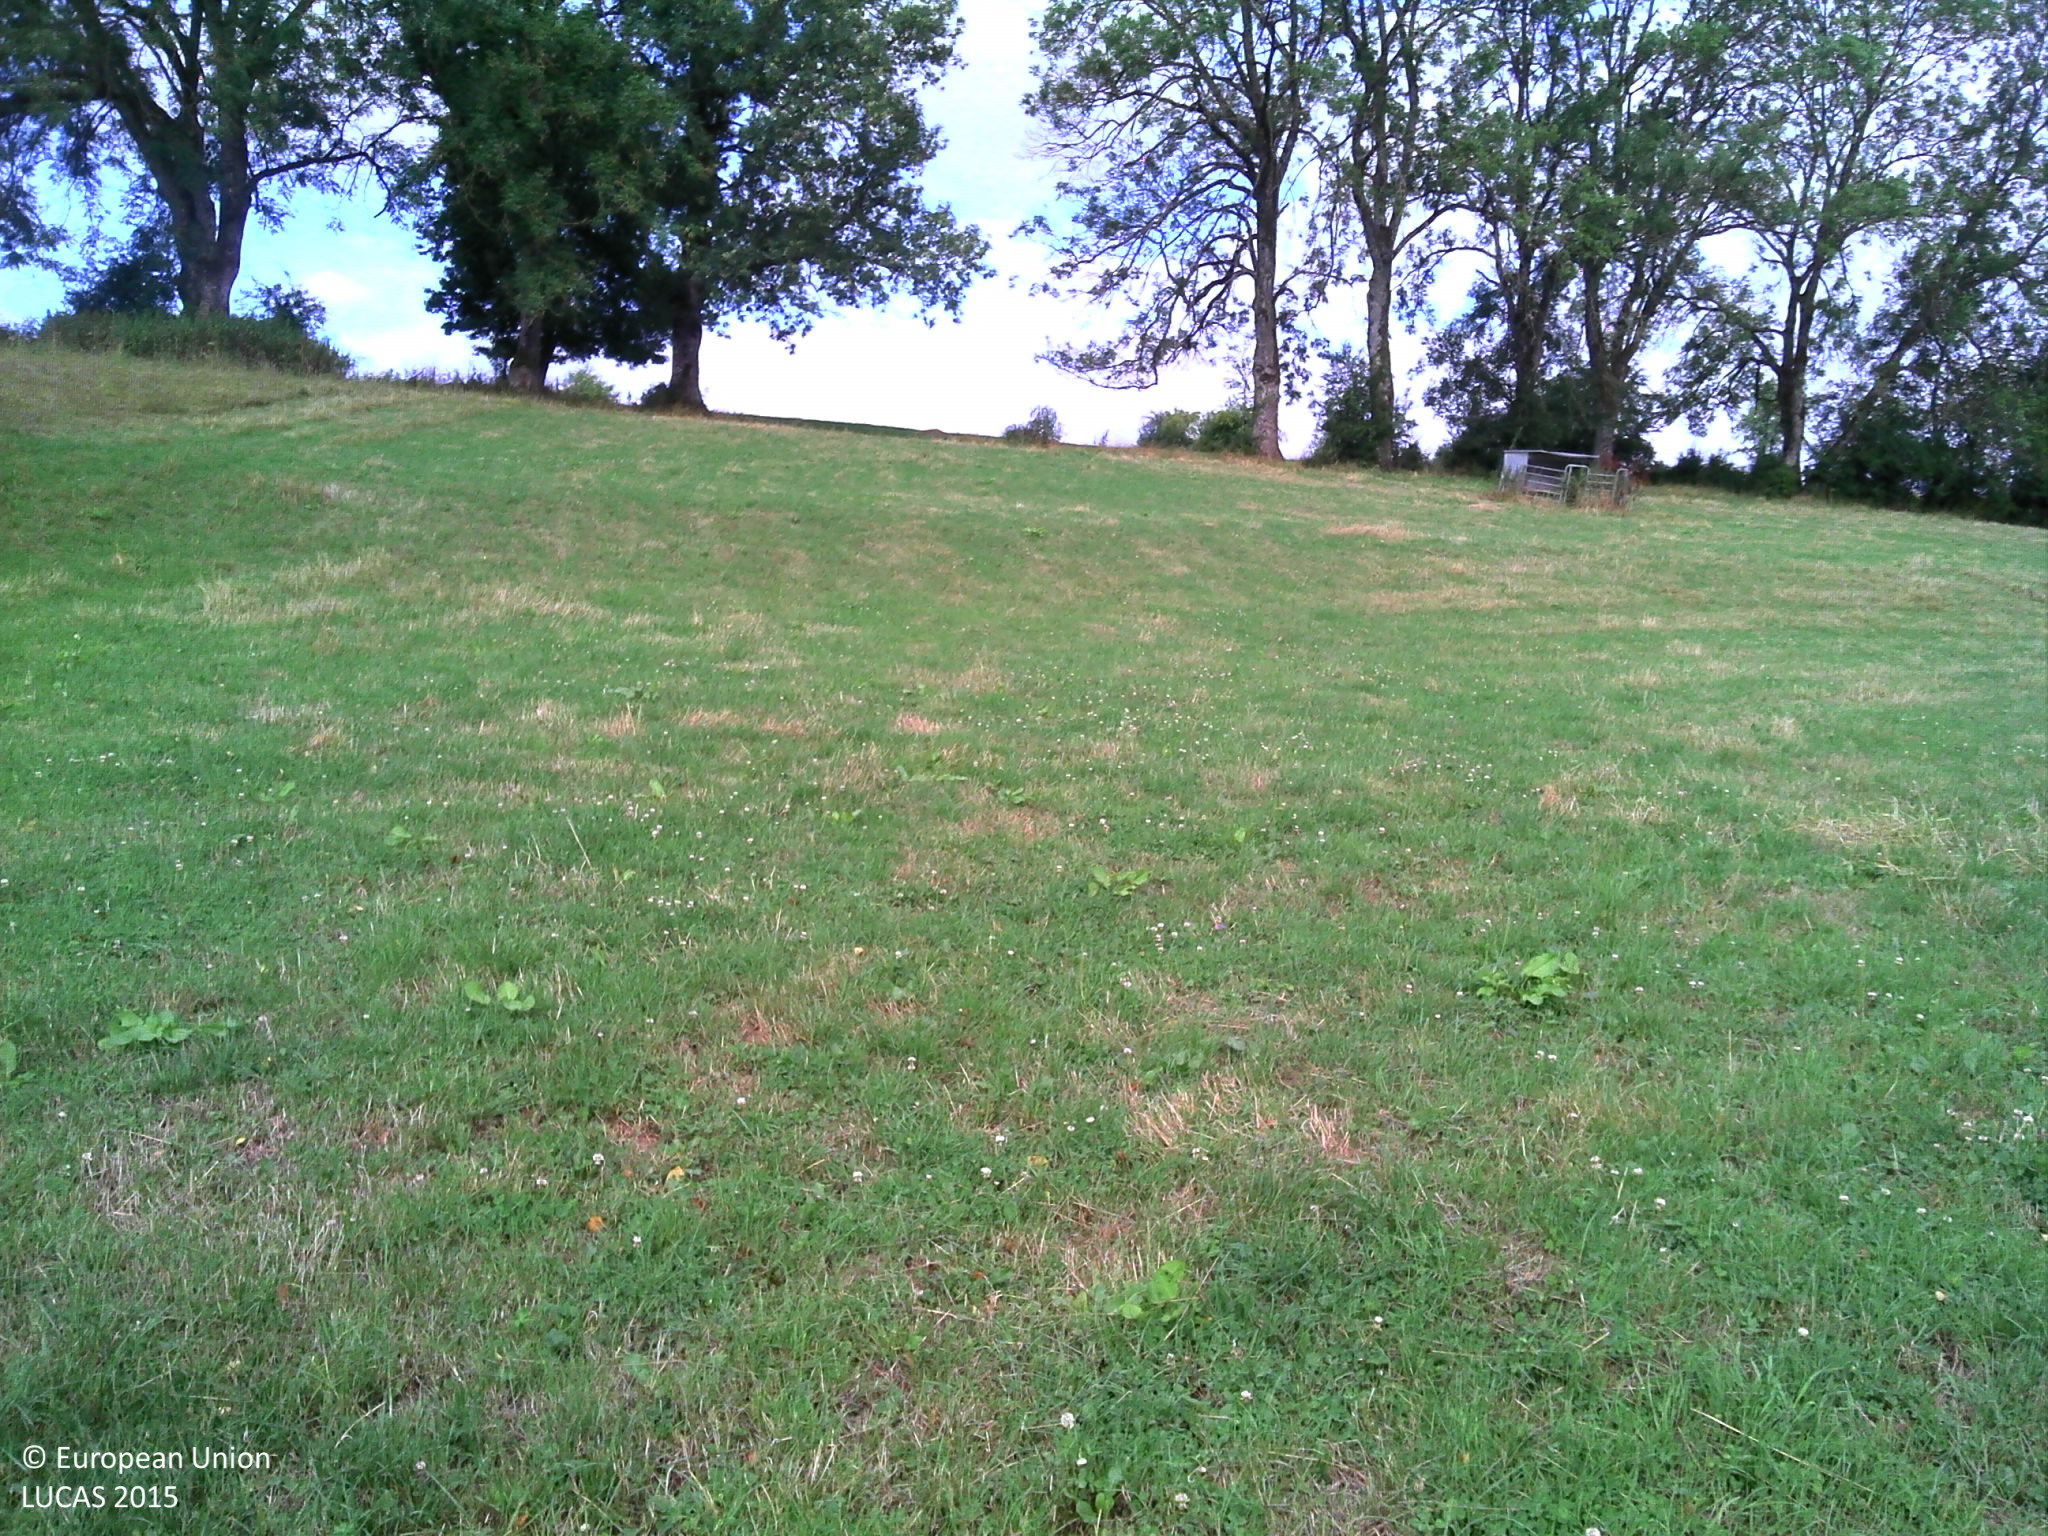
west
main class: Grassland
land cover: Grassland without tree/shrub cover
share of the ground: > 75 %
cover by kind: herbaceous plants 100 %
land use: Agriculture (excluding fallow land and kitchen gardens)
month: July
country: BE
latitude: 49.7090
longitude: 5.2970
